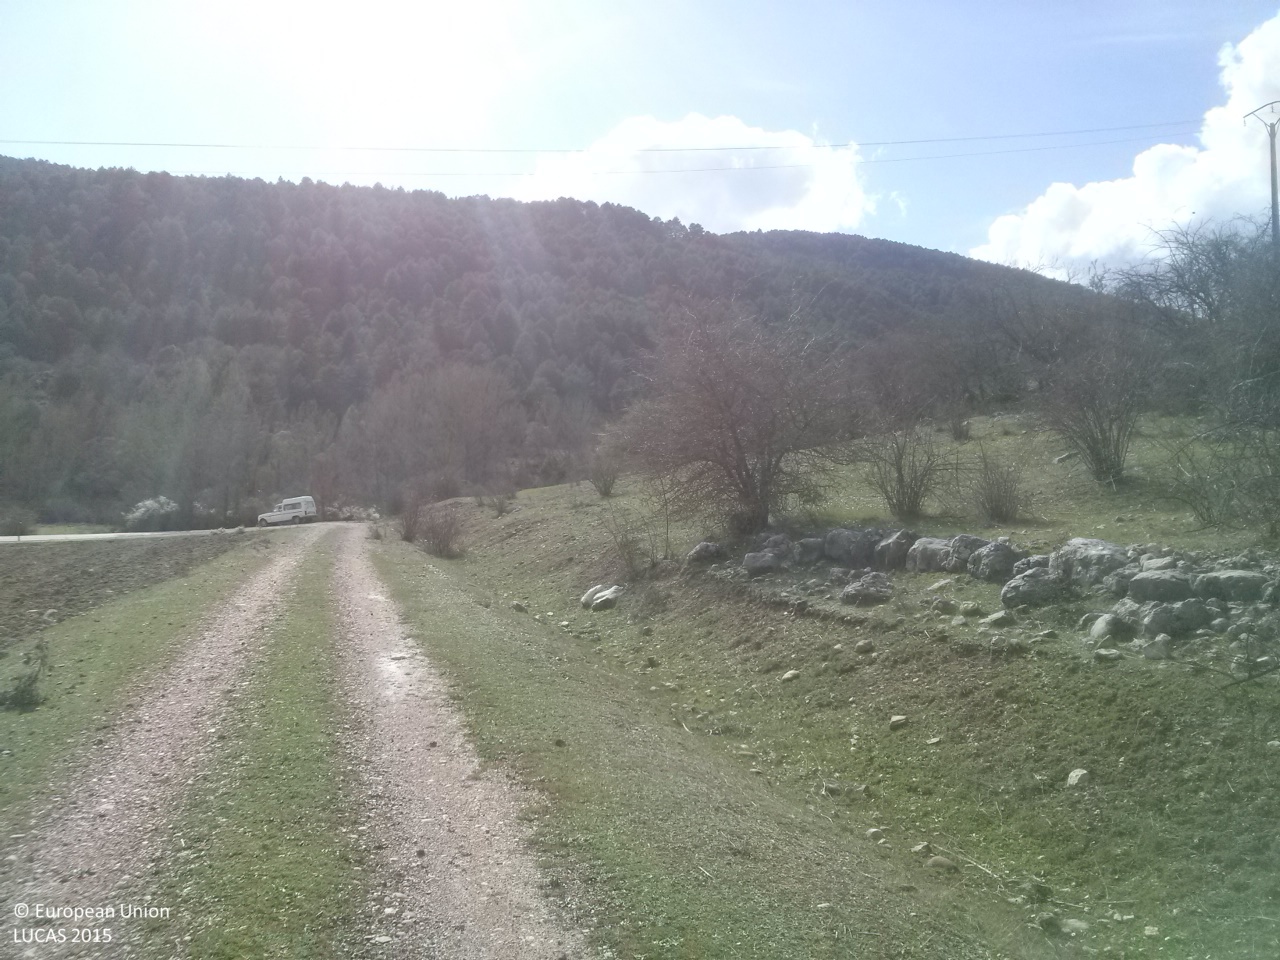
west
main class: Grassland
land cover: Grassland with sparse tree/shrub cover
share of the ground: 50 - 75 %
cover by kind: herbaceous plants 90 %, coniferous forest trees 5 %, shrubs 5 %
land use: Agriculture (excluding fallow land and kitchen gardens)
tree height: < 5 m
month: April
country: ES
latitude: 40.2515
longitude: -1.7593
